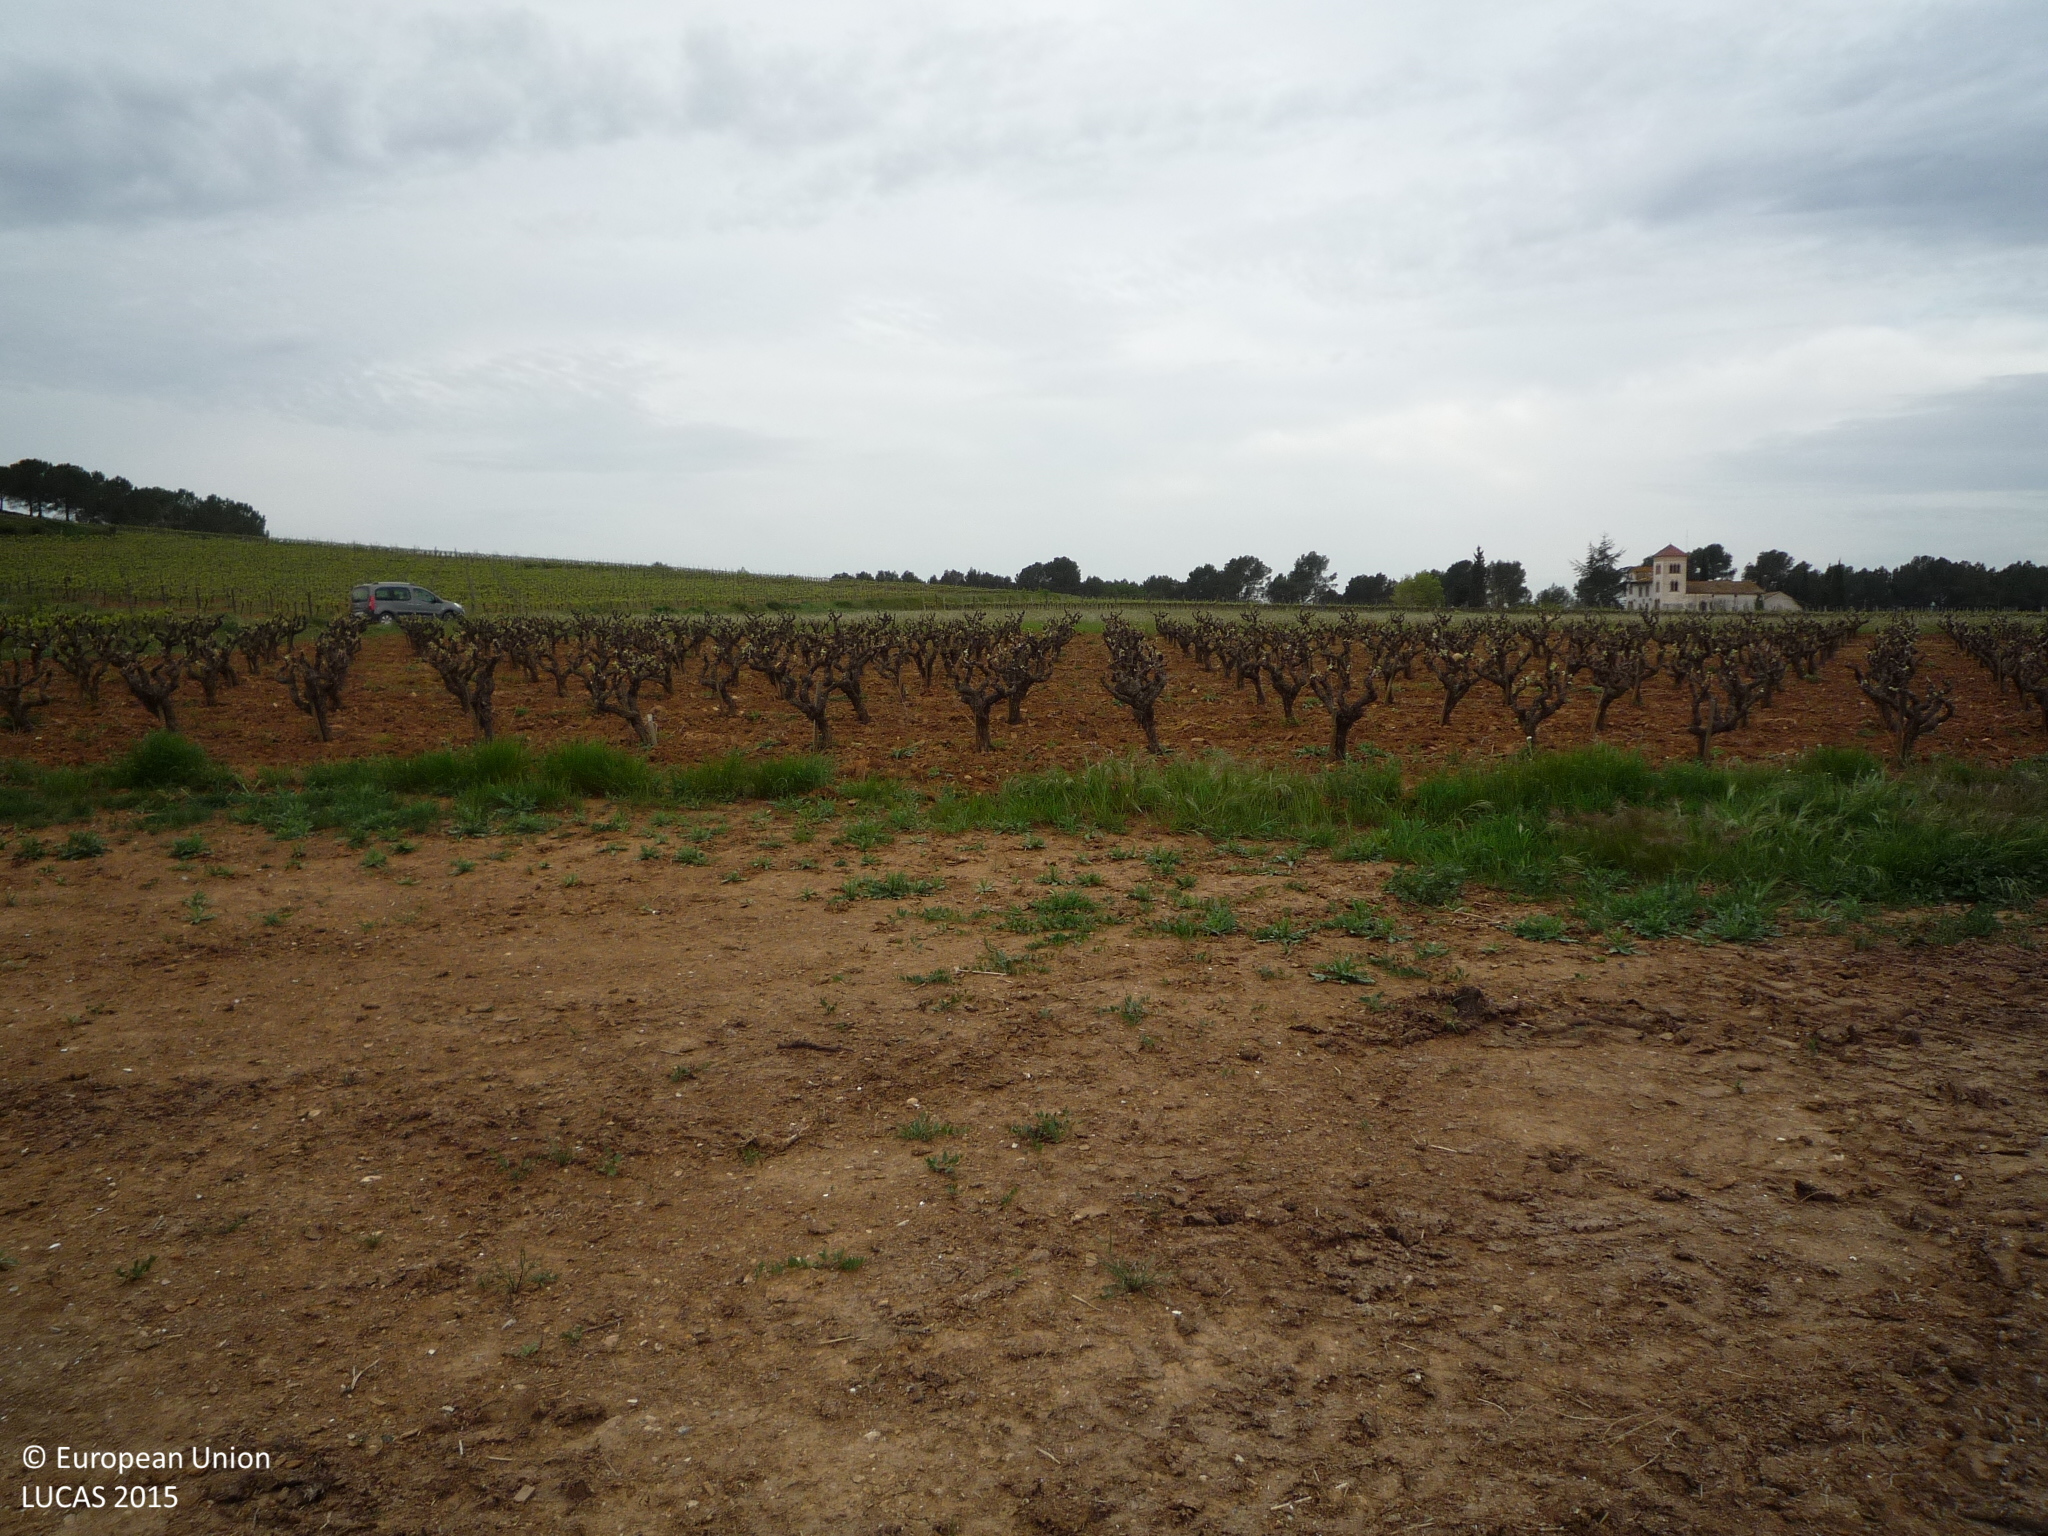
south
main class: Grassland
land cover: Grassland without tree/shrub cover
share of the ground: > 75 %
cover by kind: herbaceous plants 100 %
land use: Abandoned areas
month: April
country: ES
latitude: 41.4075
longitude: 1.7270
